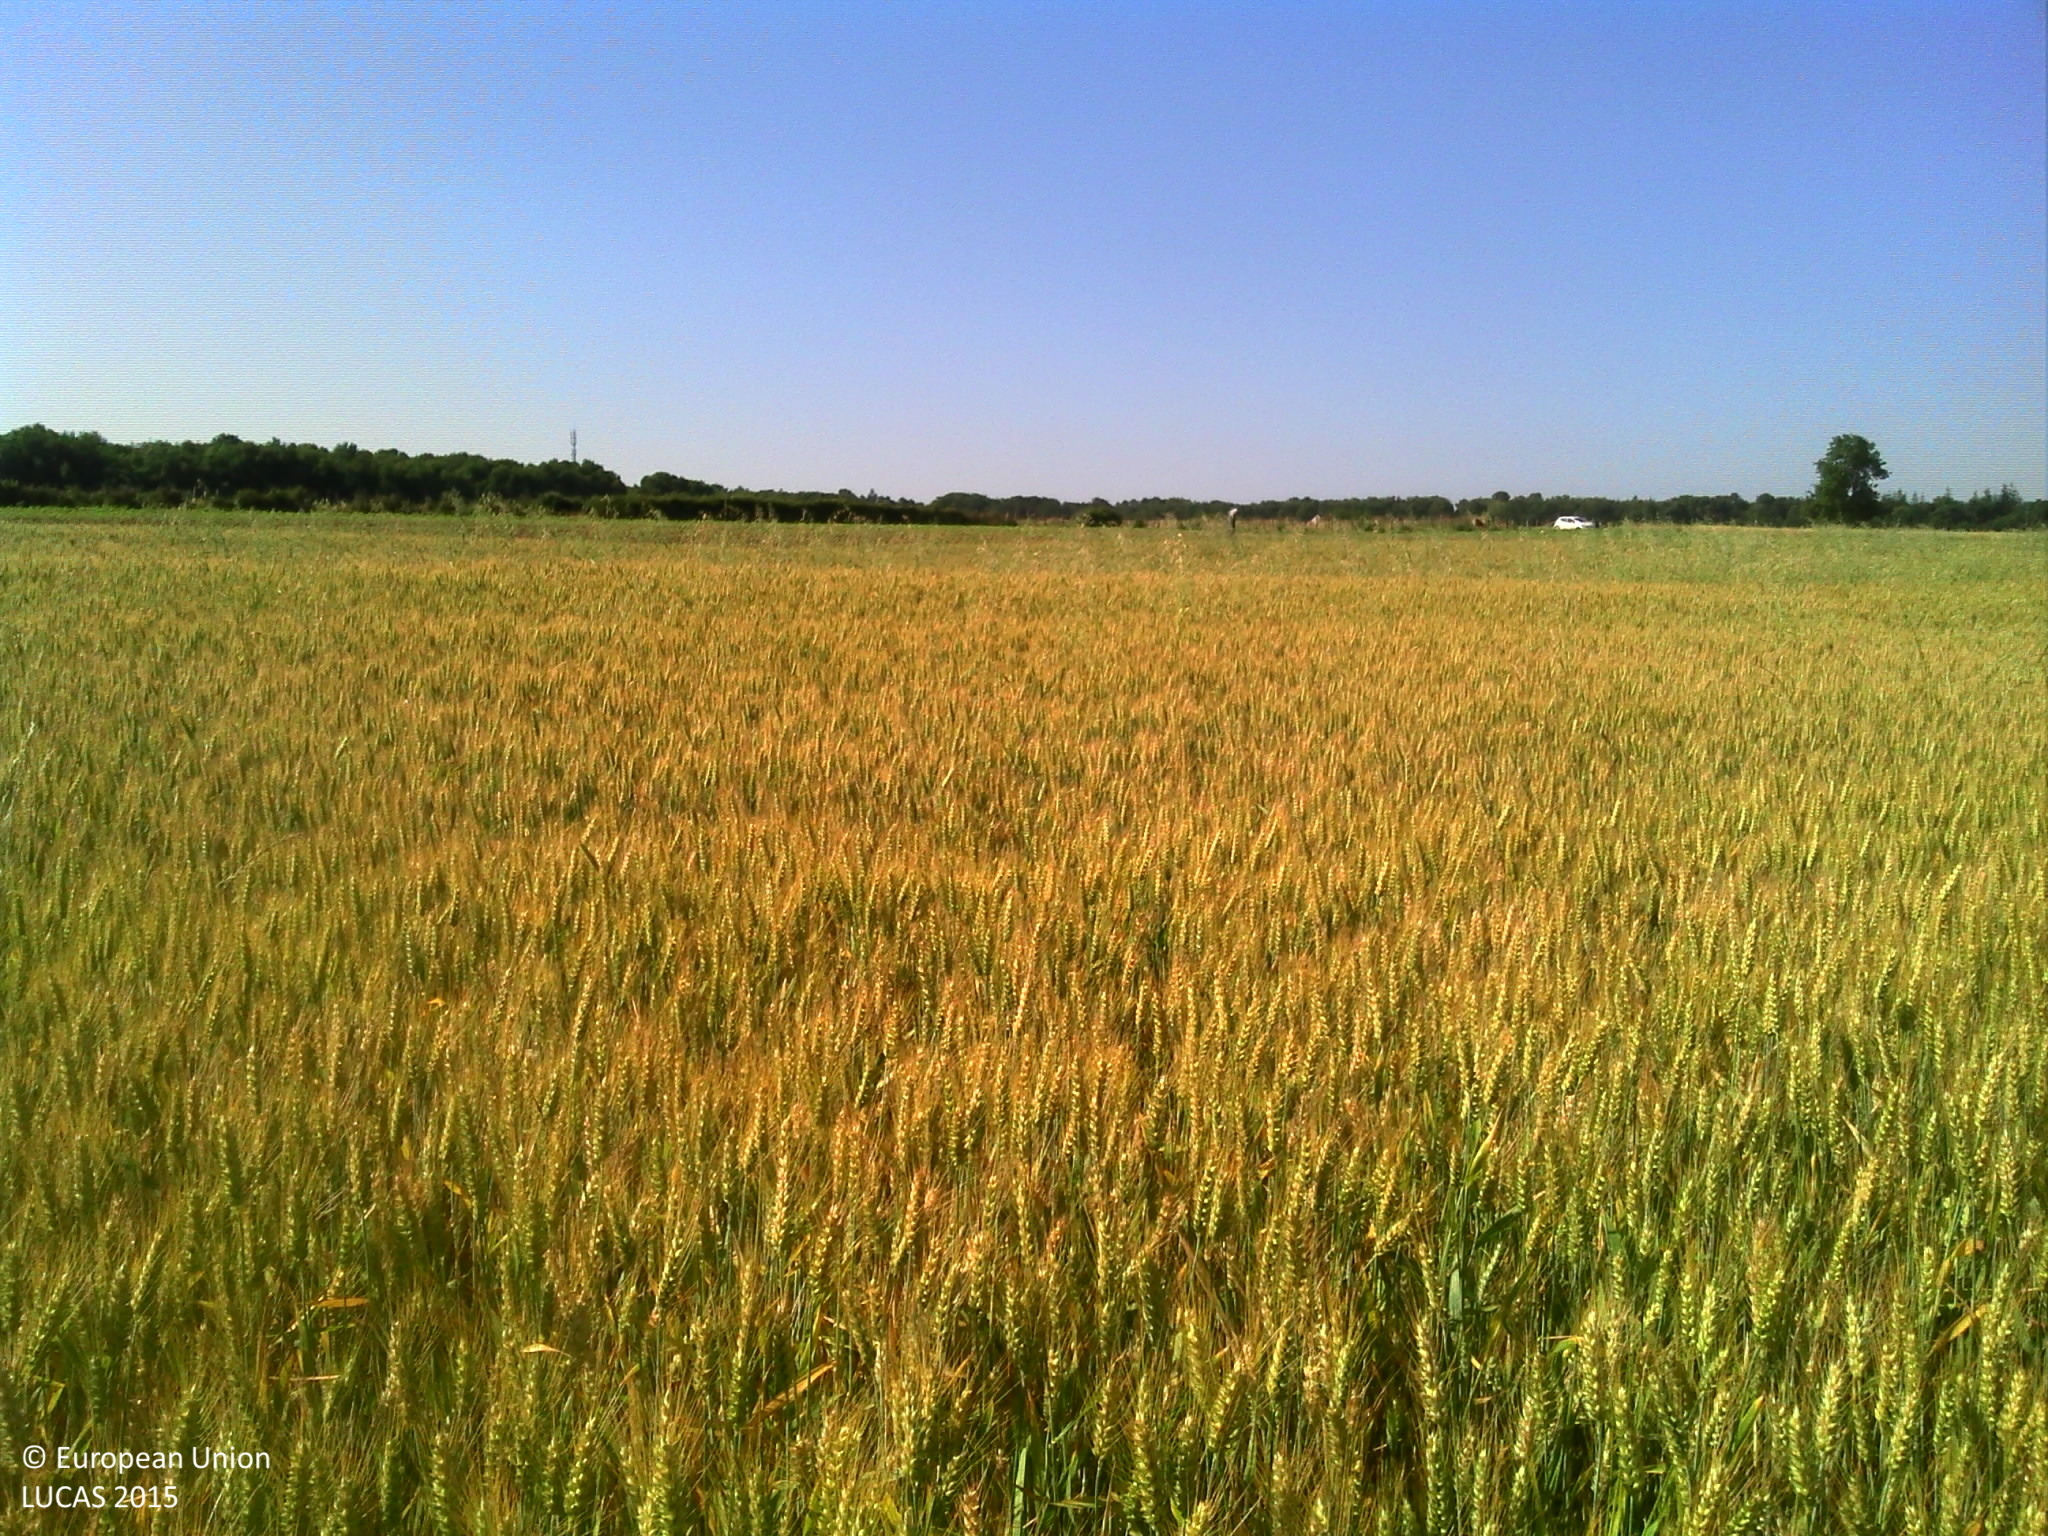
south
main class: Cropland
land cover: Durum wheat
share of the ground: > 75 %
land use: Agriculture (excluding fallow land and kitchen gardens)
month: June
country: FR
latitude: 47.5032
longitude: 0.4861
